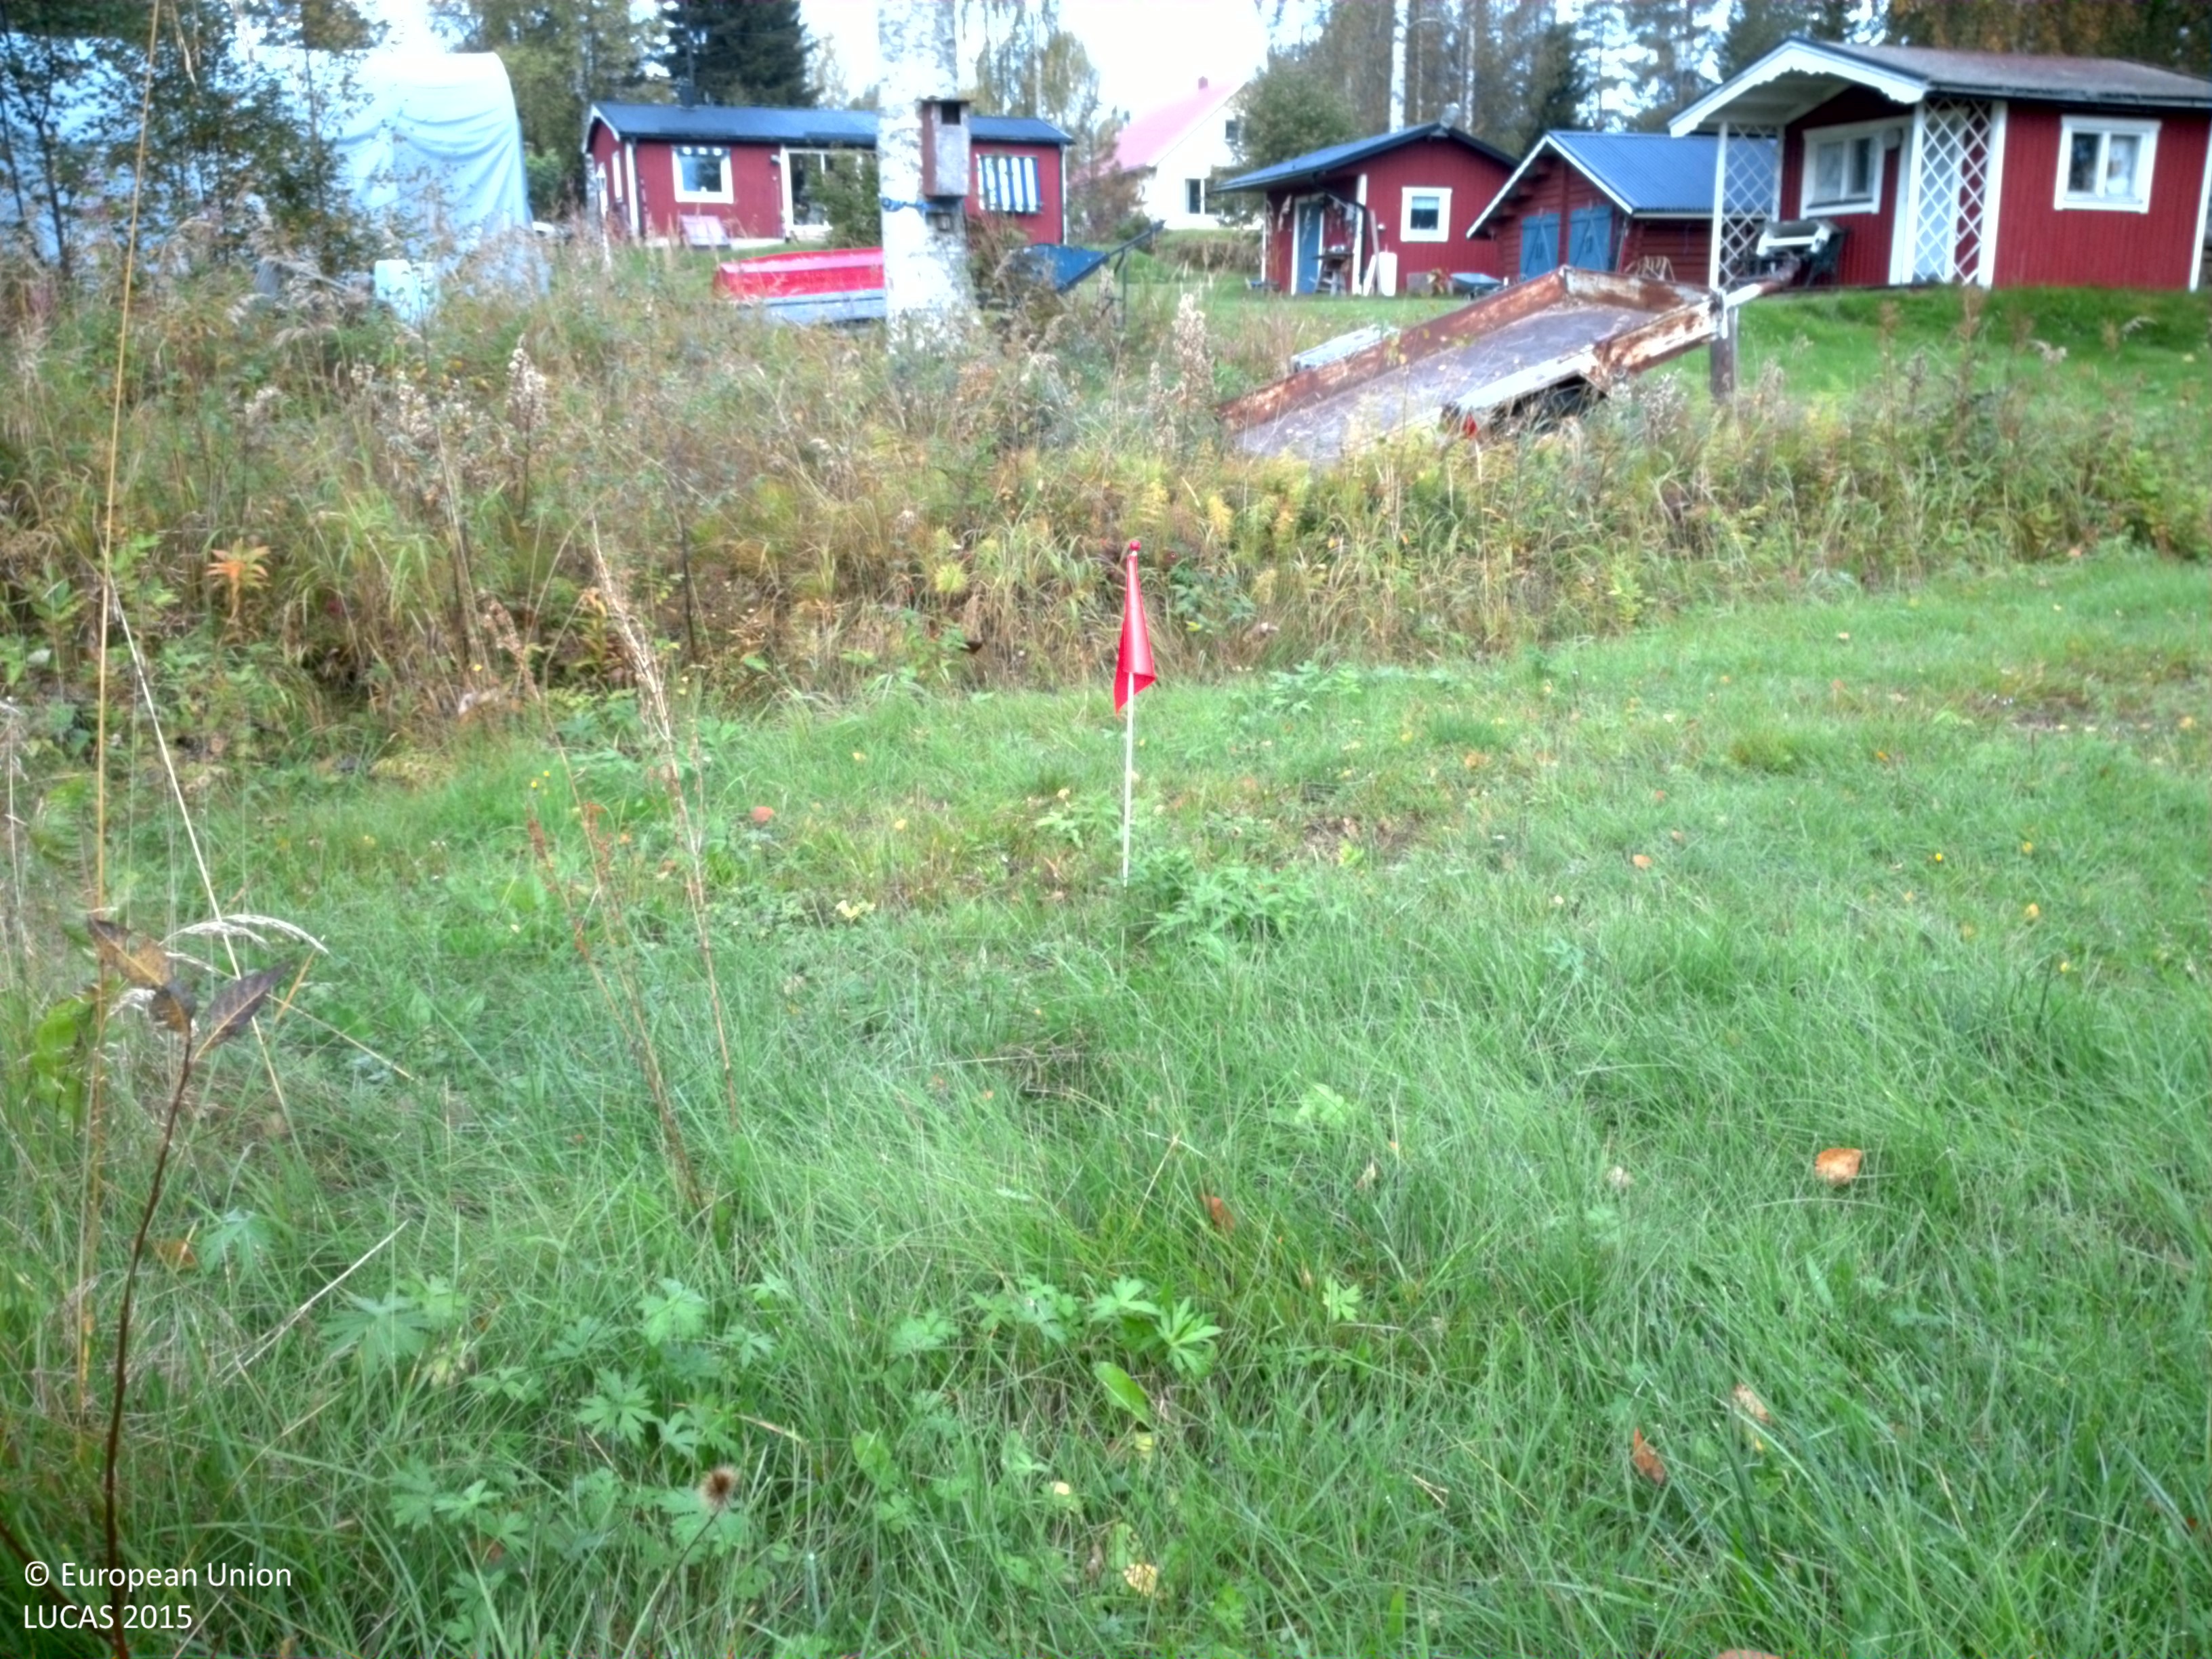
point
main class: Grassland
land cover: Grassland without tree/shrub cover
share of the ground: > 75 %
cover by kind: herbaceous plants 100 %
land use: Residential
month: September
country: SE
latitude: 65.5120
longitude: 22.0658
